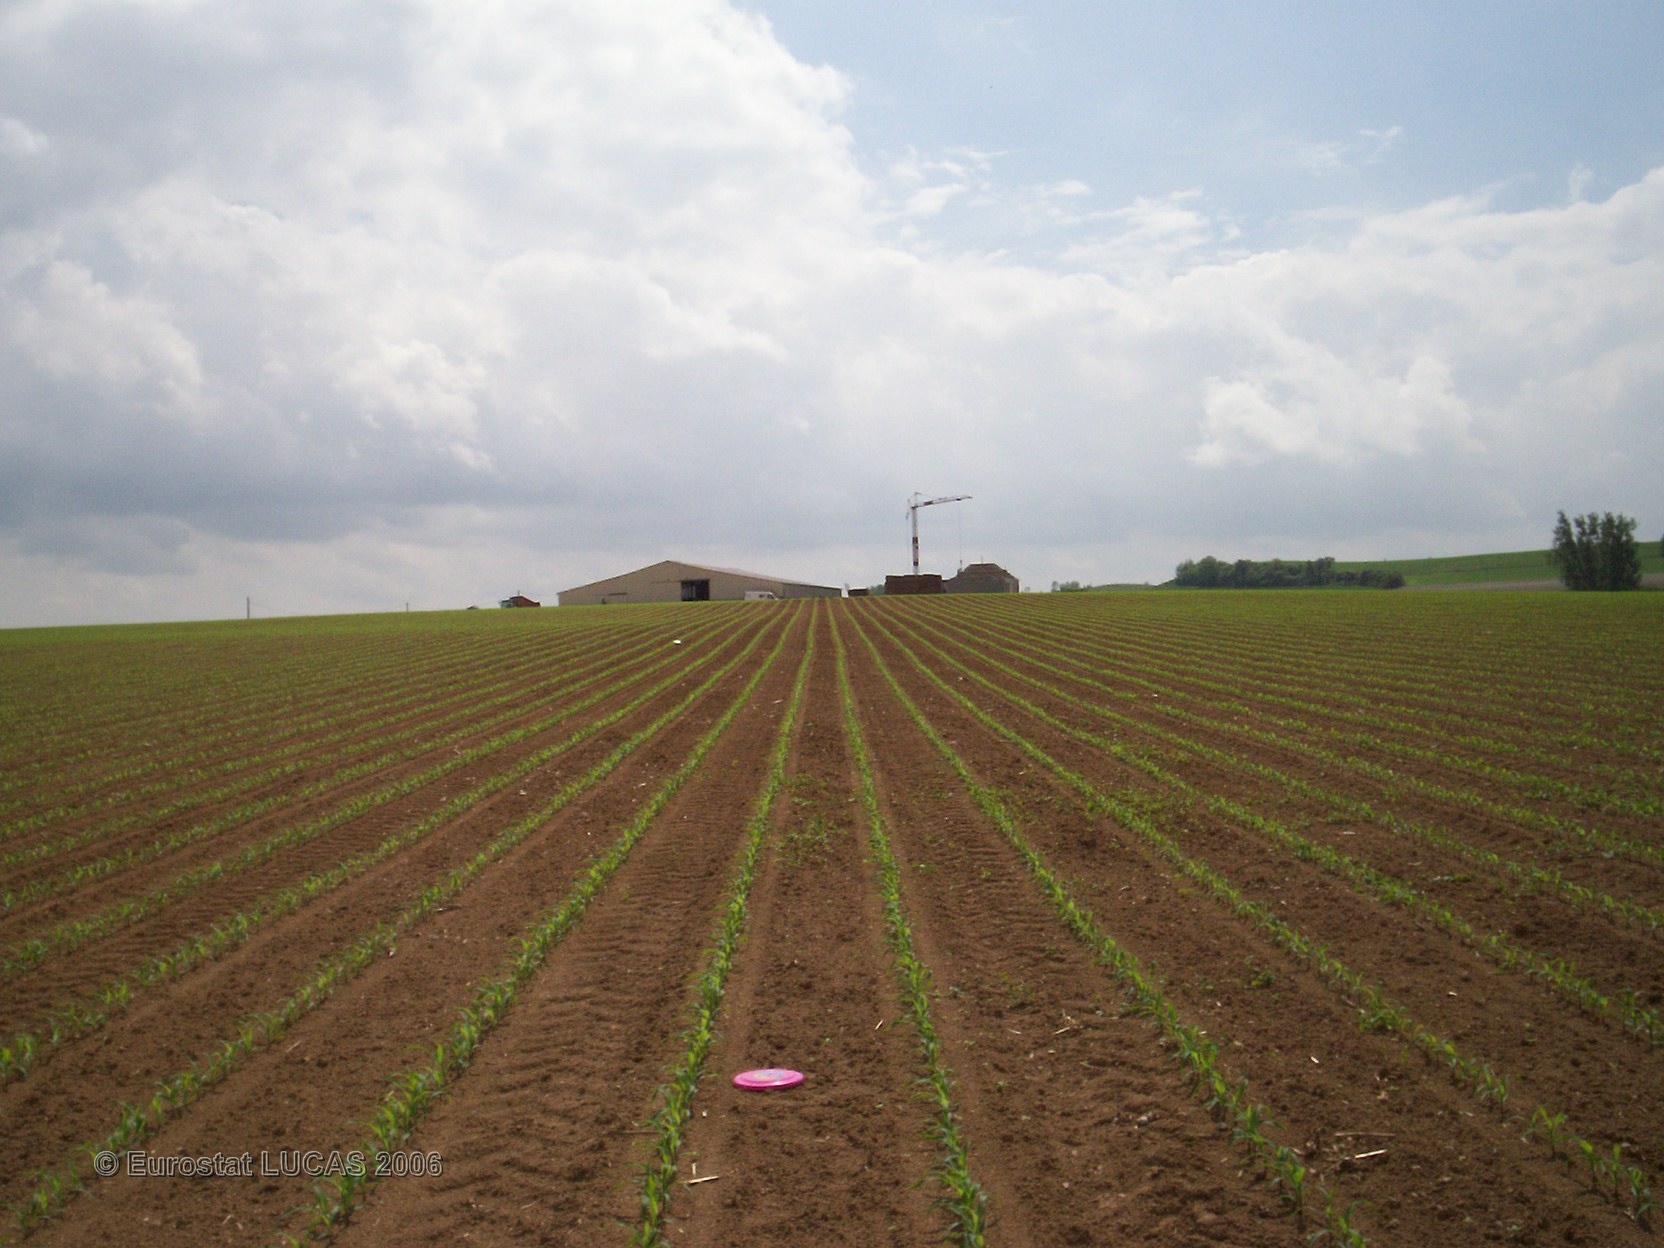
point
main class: Cropland
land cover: Maize
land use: Agriculture (excluding fallow land and kitchen gardens)
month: May
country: FR
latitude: 49.5432
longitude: 4.4265
